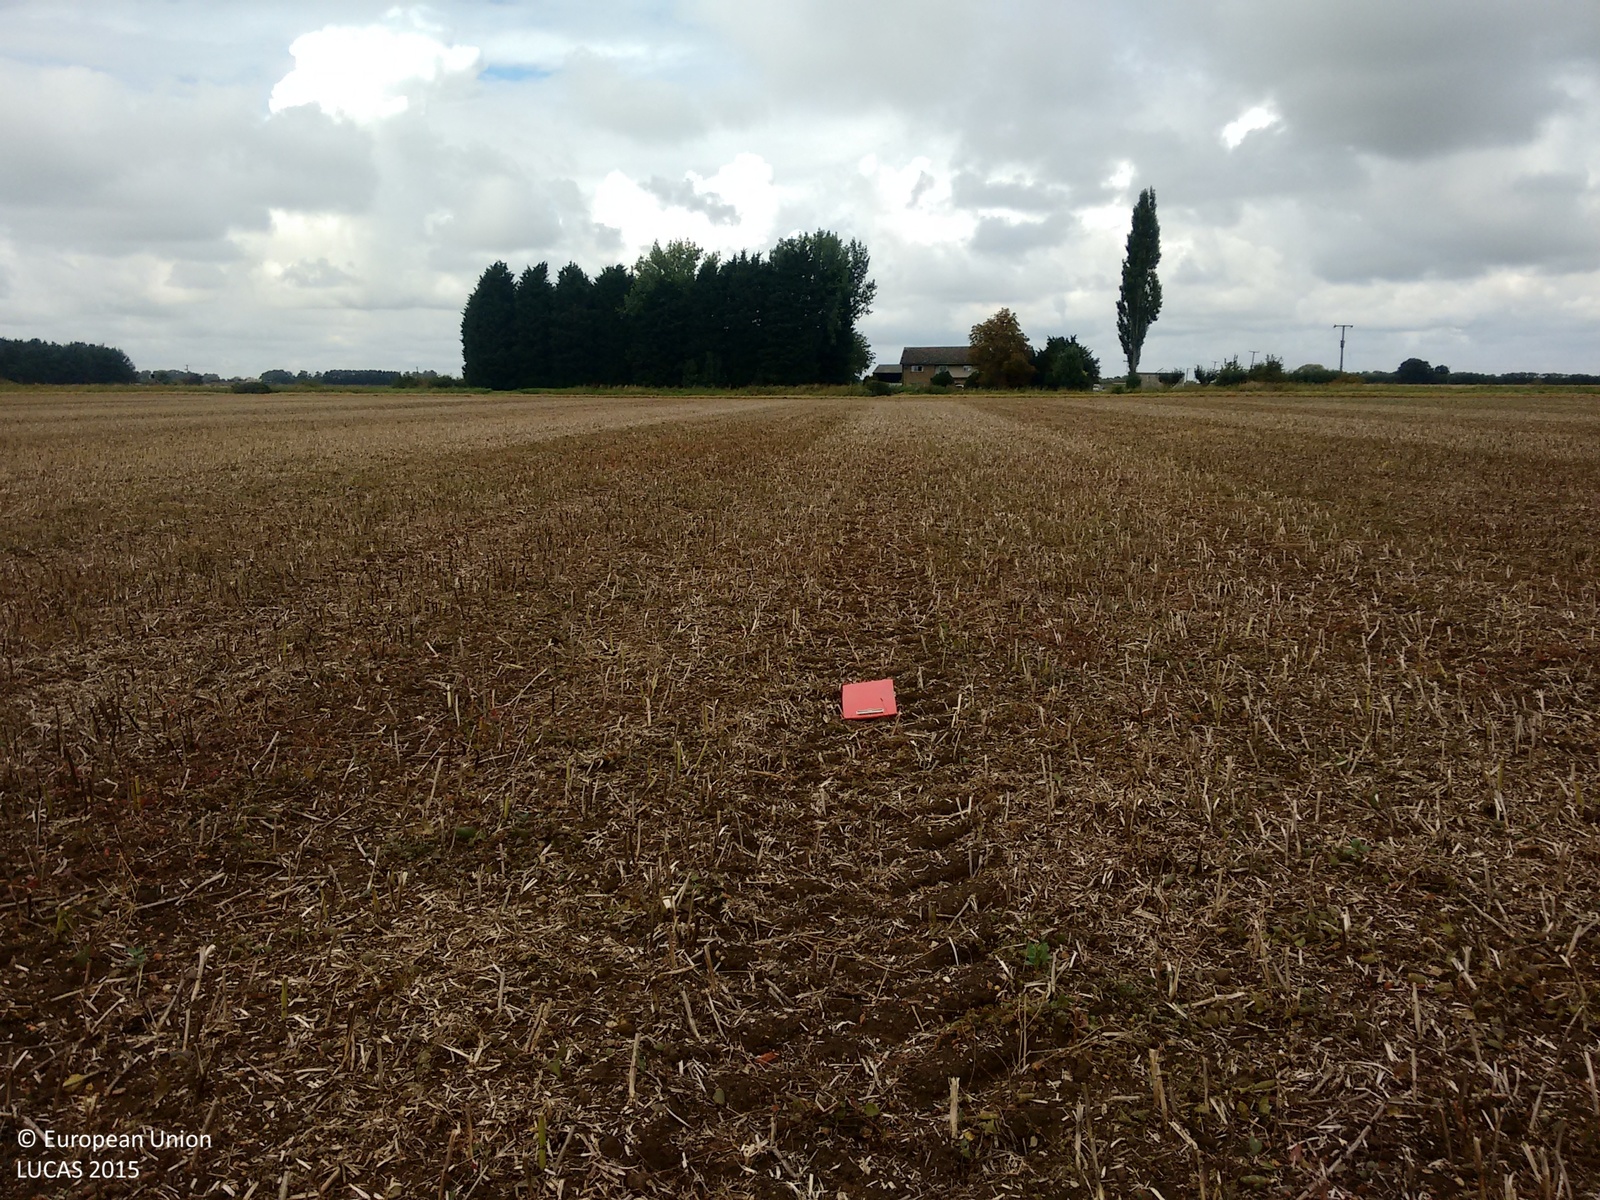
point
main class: Cropland
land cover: Dry pulses
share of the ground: < 10 %
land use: Agriculture (excluding fallow land and kitchen gardens)
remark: Harvested field
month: September
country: GB
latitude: 52.2938
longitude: 0.1600
